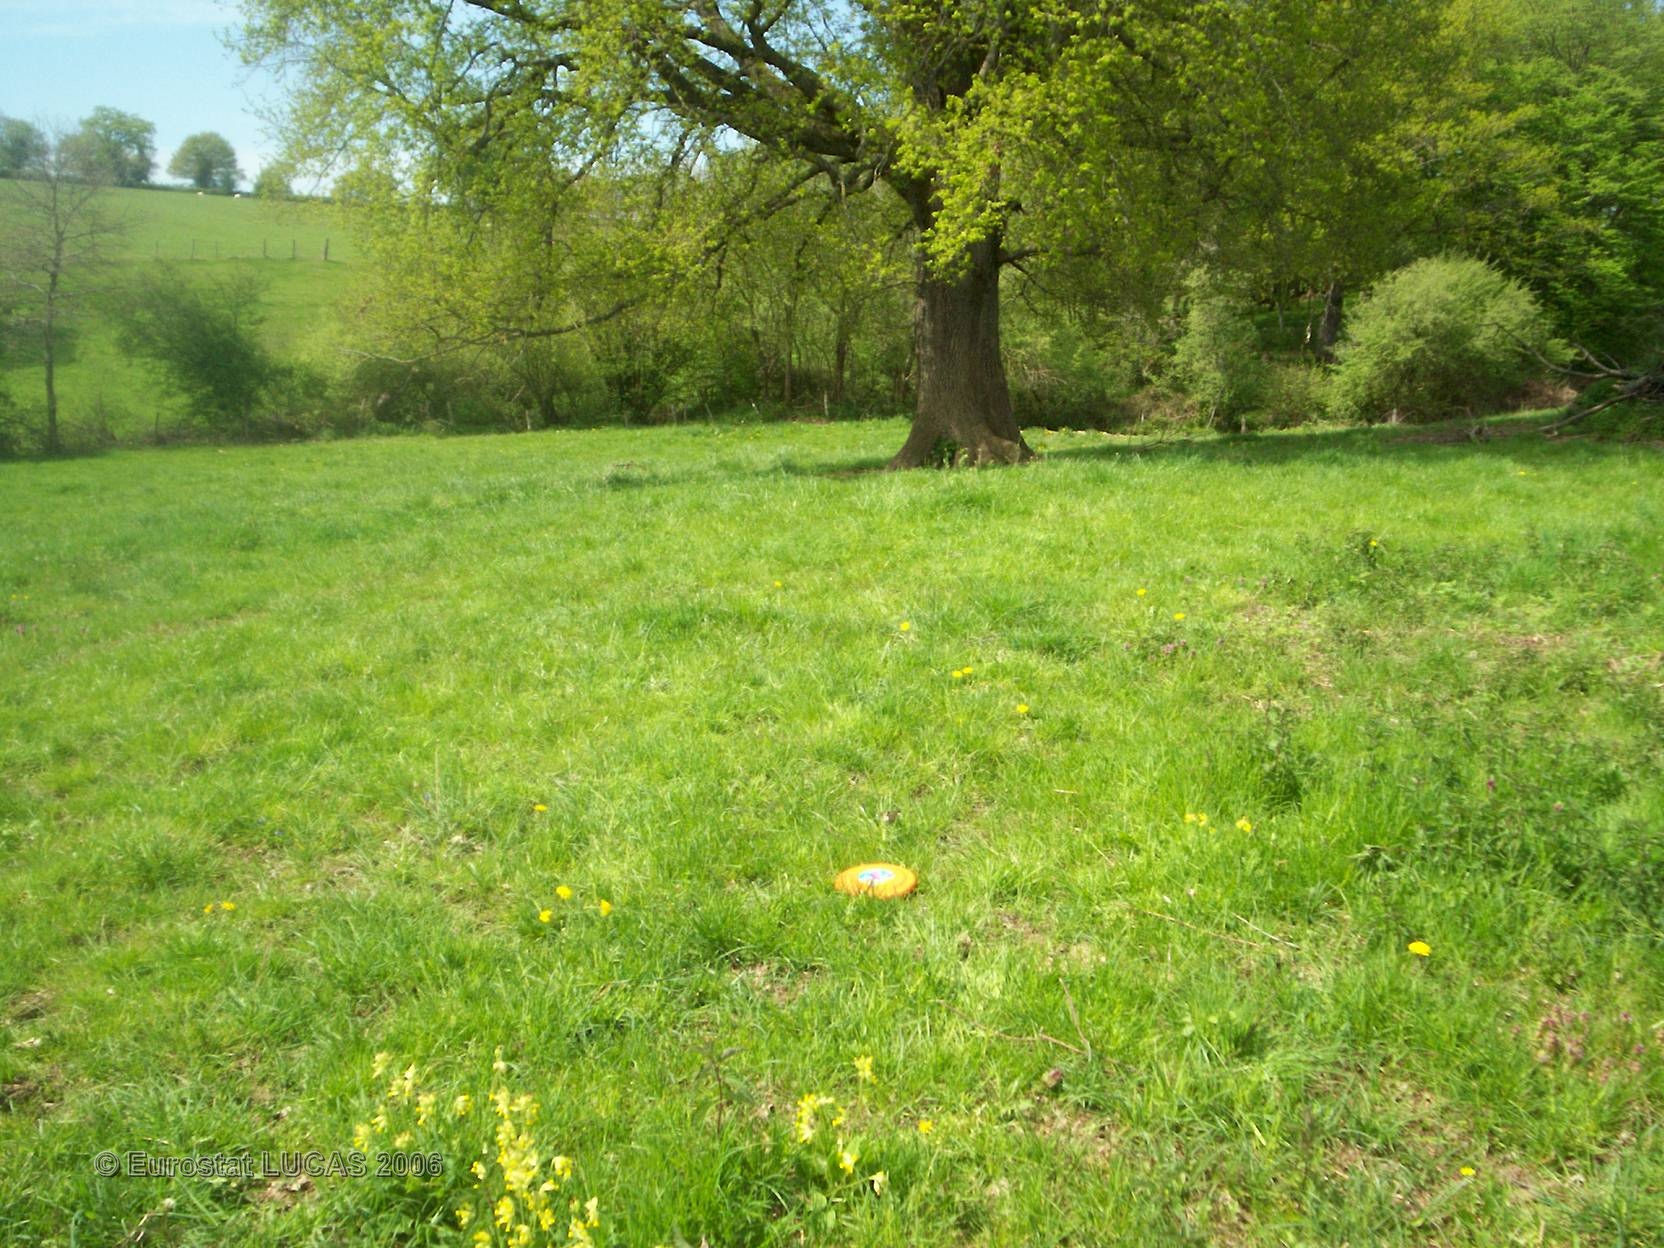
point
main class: Grassland
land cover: Grassland without tree/shrub cover
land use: Agriculture (excluding fallow land and kitchen gardens)
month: May
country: FR
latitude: 46.3826
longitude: 3.1197
